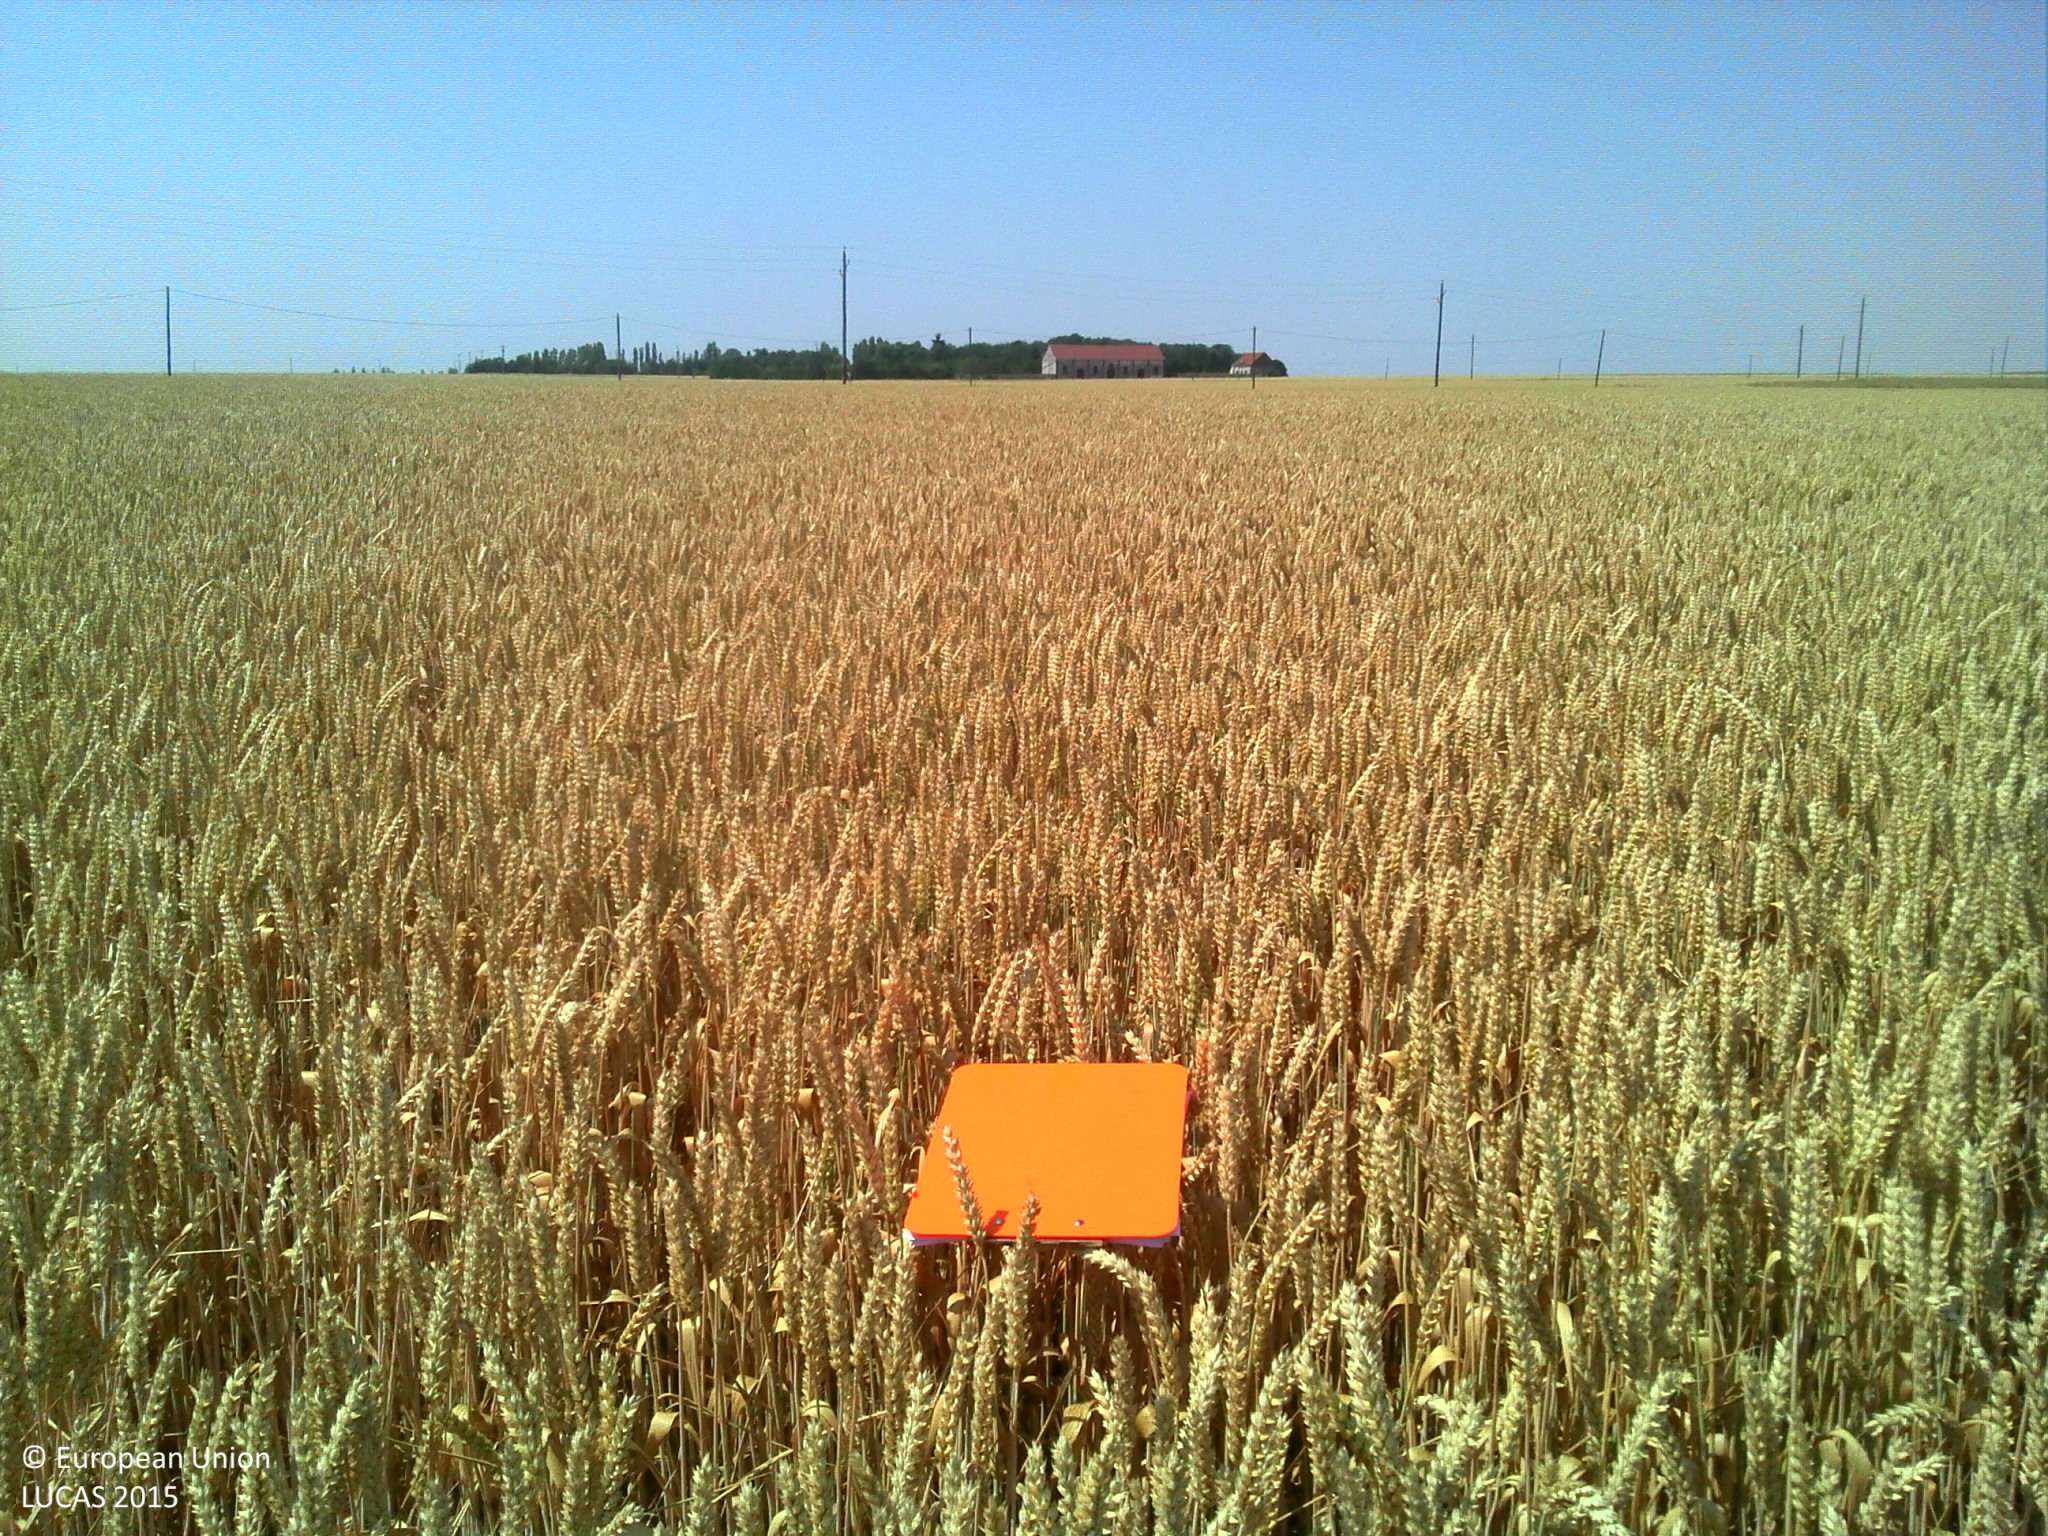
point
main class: Cropland
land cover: Common wheat
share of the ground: > 75 %
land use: Agriculture (excluding fallow land and kitchen gardens)
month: July
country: FR
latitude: 48.9118
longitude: 1.3166
